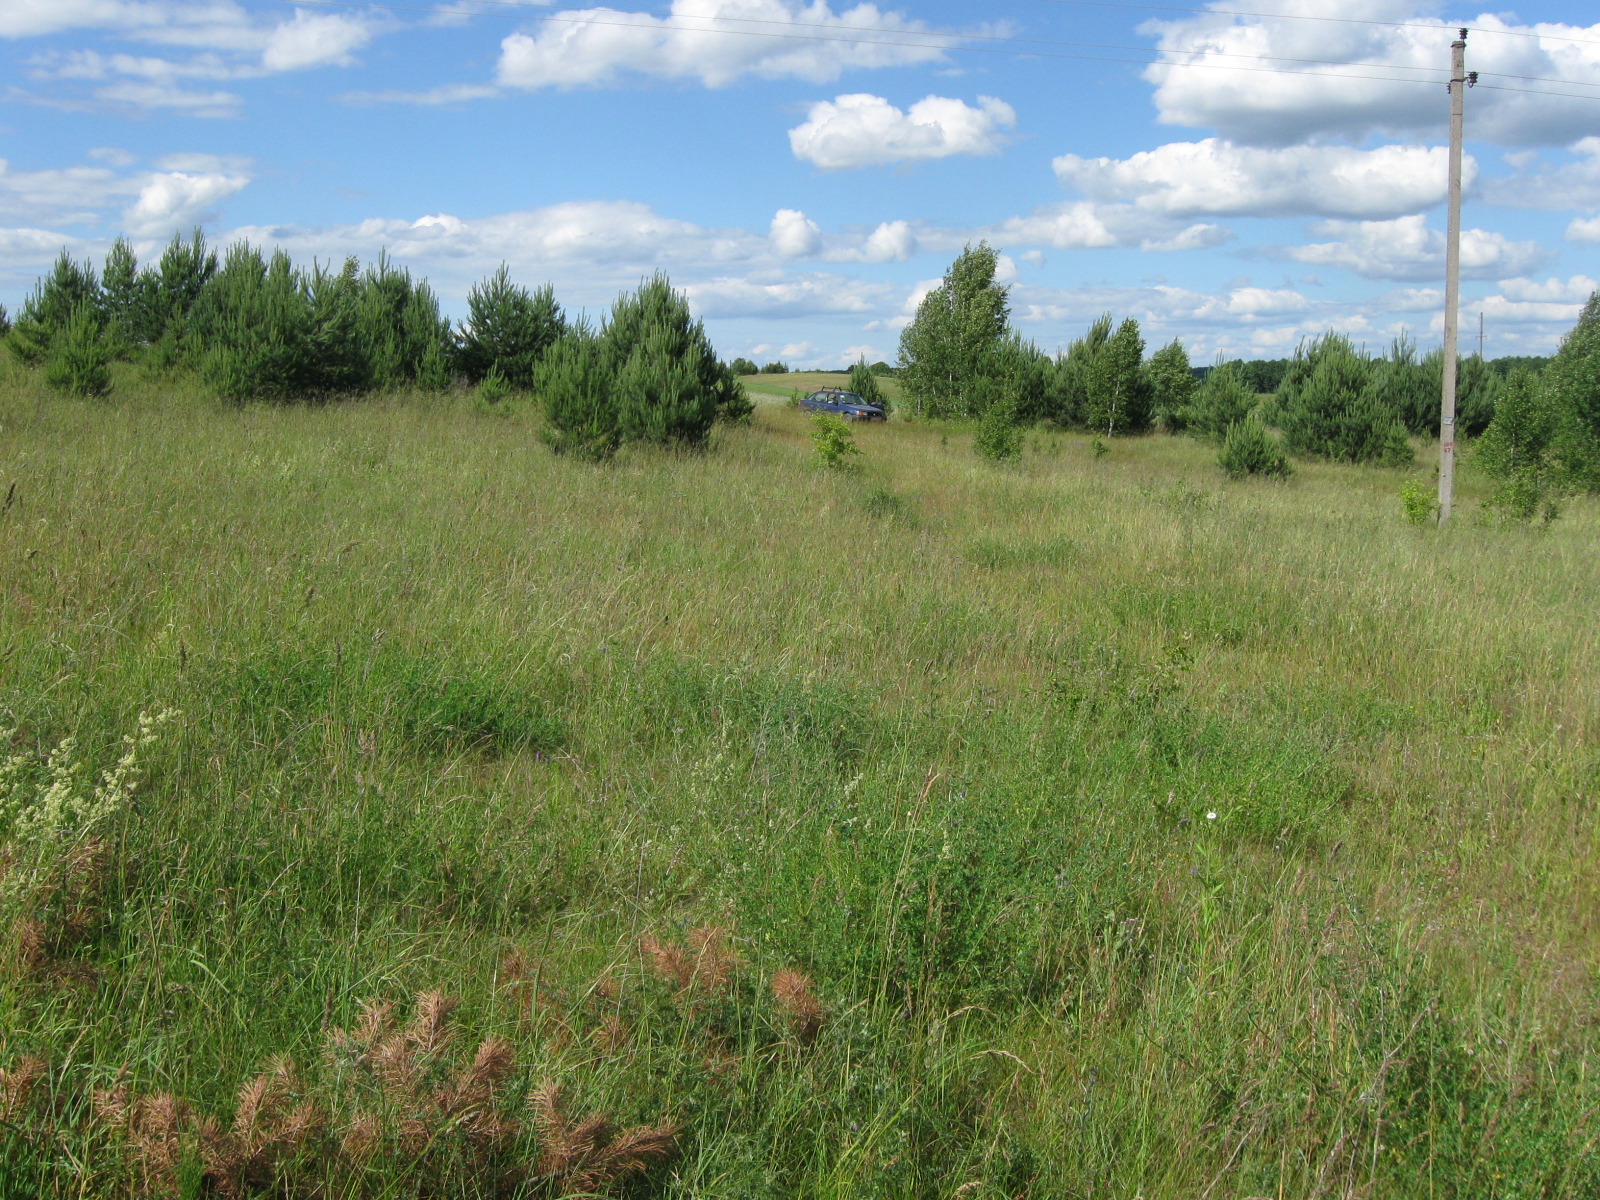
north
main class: Grassland
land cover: Grassland with sparse tree/shrub cover
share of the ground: > 75 %
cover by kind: herbaceous plants 95 %, broadleaved forest trees 5 %
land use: Agriculture (excluding fallow land and kitchen gardens)
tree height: < 5 m
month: June
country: LT
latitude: 54.4964
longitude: 24.6668
